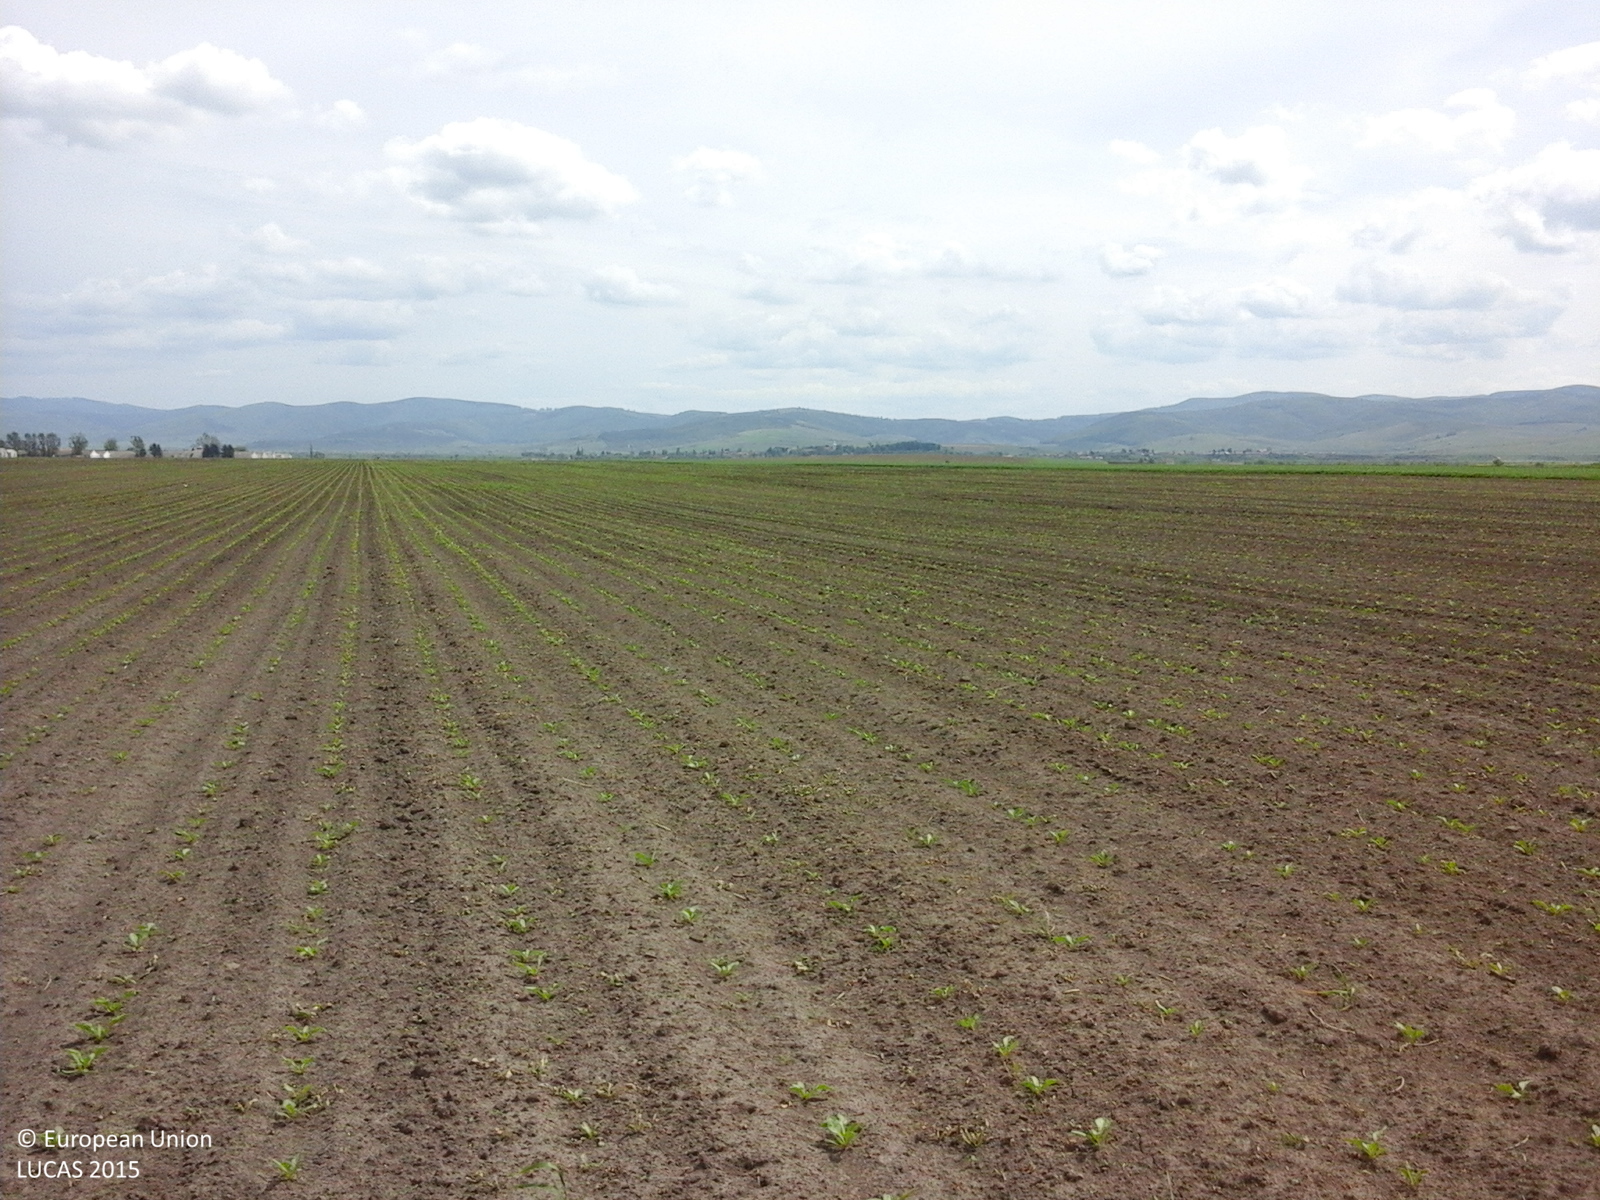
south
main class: Cropland
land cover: Sugar beet
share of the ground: < 10 %
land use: Agriculture (excluding fallow land and kitchen gardens)
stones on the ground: < 10 %
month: May
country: RO
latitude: 45.8532
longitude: 25.9948
